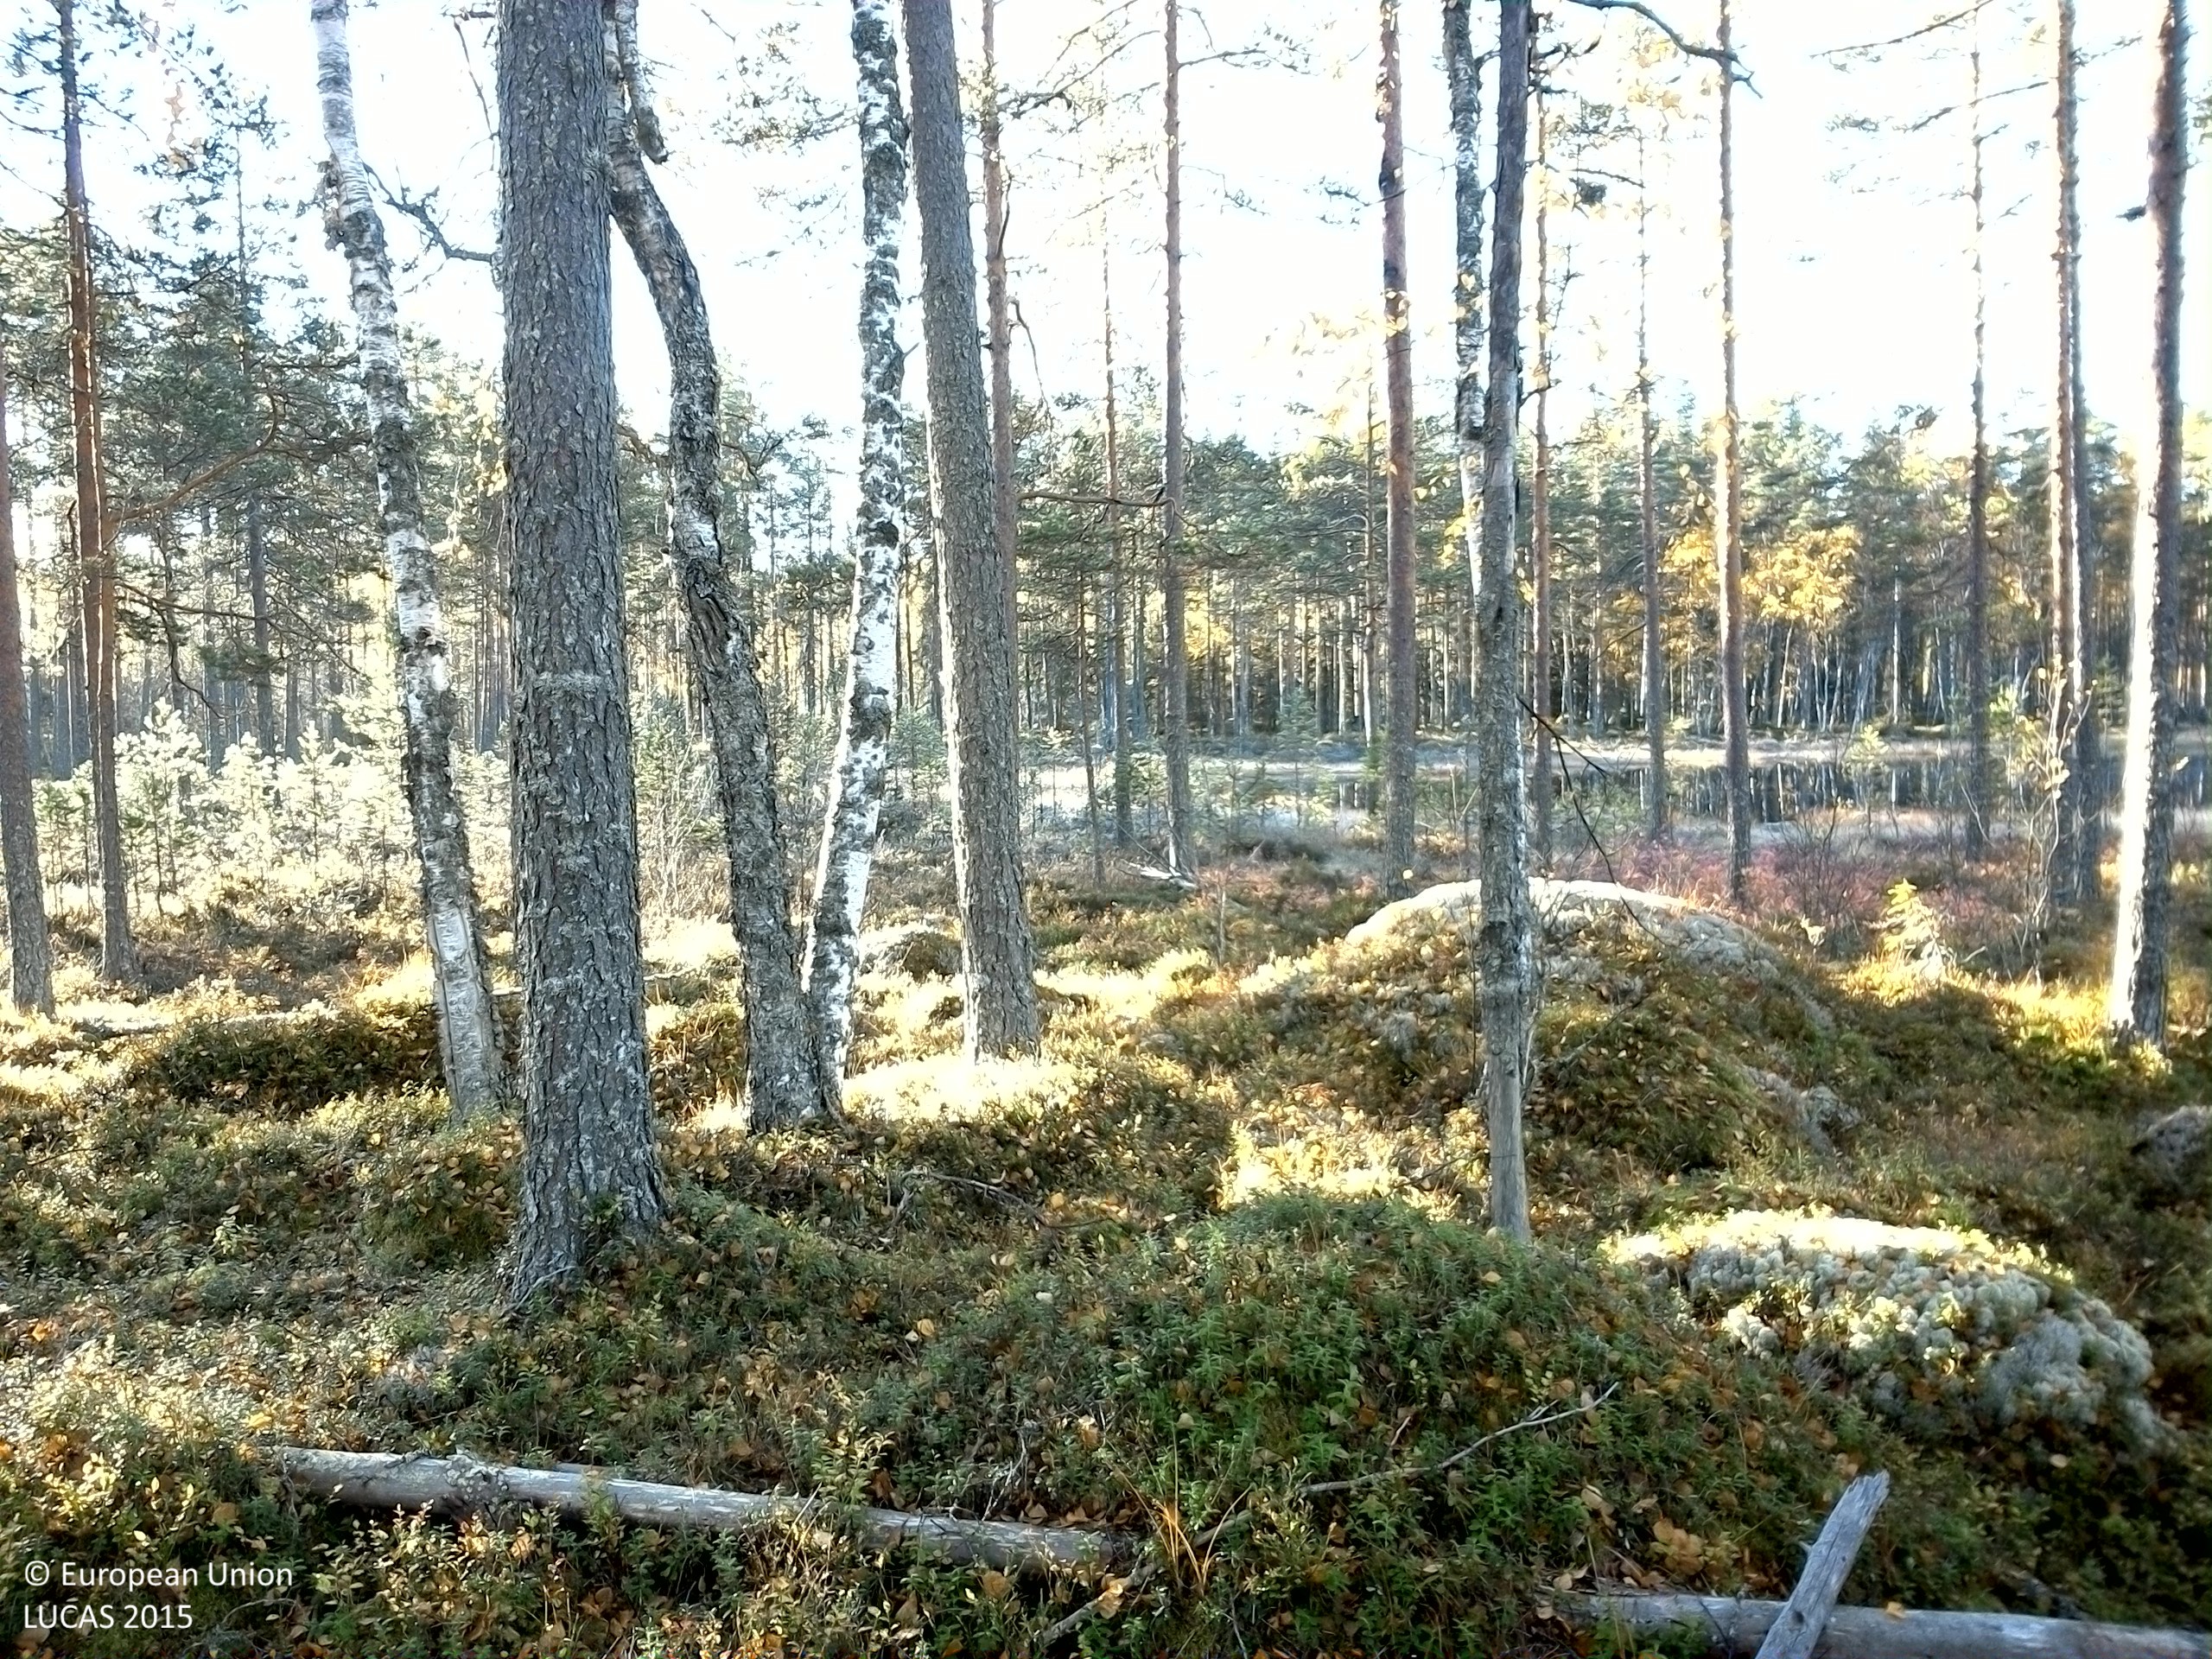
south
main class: Woodland
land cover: Pine dominated mixed woodland
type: boreal forest
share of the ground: 50 - 75 %
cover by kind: coniferous forest trees 35 %, shrubs 25 %, broadleaved forest trees 20 %, lichens and mosses 10 %, consolidated bare surface 10 %
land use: Forestry
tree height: > 5 m
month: October
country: SE
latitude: 61.3702
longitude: 15.0923
